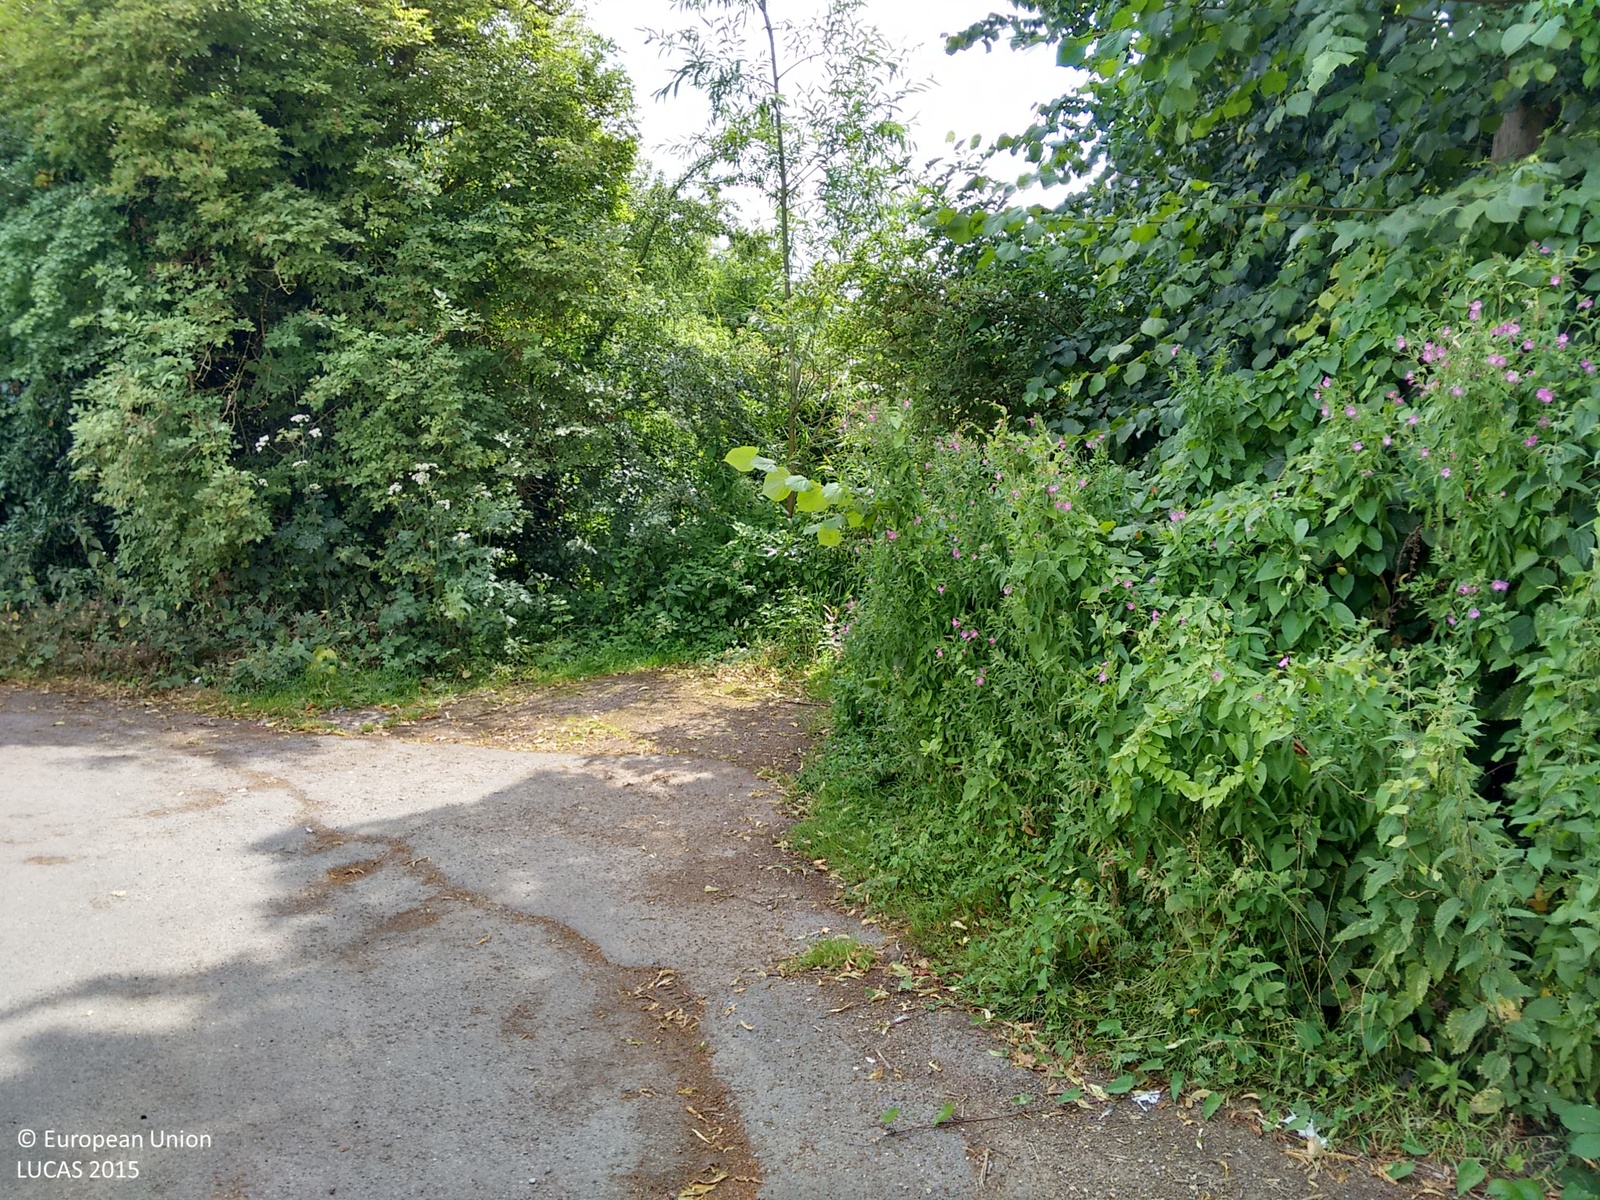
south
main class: Grassland
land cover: Grassland with sparse tree/shrub cover
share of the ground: > 75 %
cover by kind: herbaceous plants 95 %, broadleaved forest trees 5 %
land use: Agriculture (excluding fallow land and kitchen gardens)
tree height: > 5 m
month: July
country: GB
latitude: 51.7328
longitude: -1.2403
